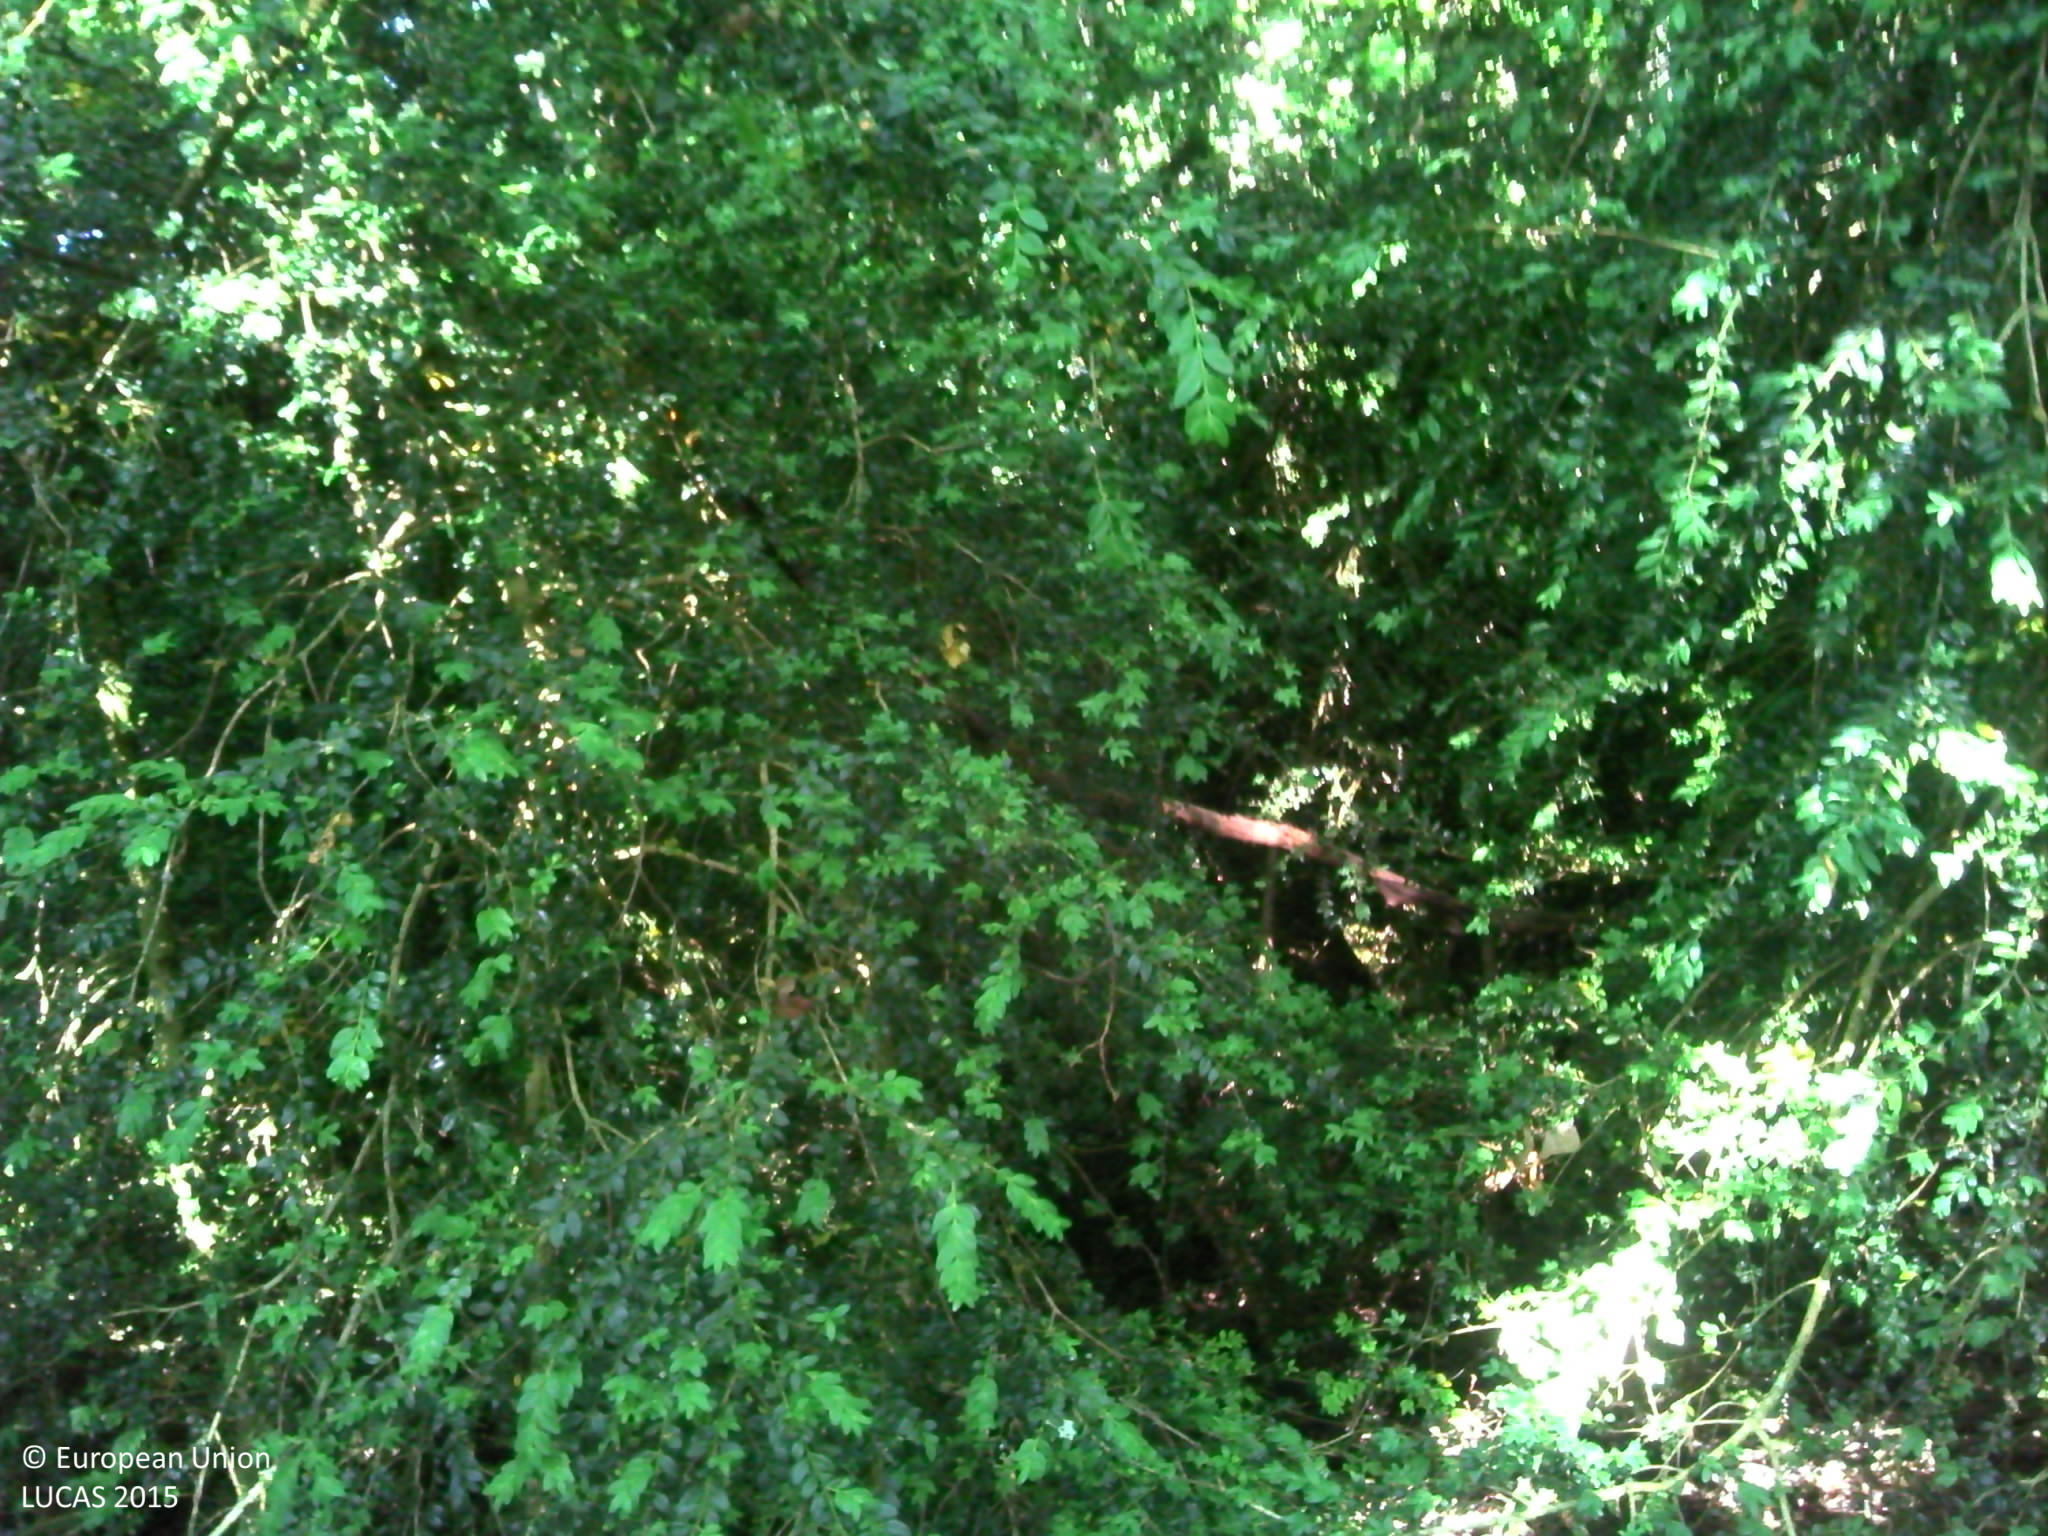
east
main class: Woodland
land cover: Broadleaved woodland
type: acidophilous oak and oak-birch forest
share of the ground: > 75 %
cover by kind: broadleaved forest trees 80 %, herbaceous plants 10 %, lichens and mosses 10 %
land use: Forestry
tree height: > 5 m
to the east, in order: Broadleaved woodland; Grass margins; Paved roads, cycling and walking lanes; Grass margins; Broadleaved woodland
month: June
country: FR
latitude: 46.6046
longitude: 4.8187
